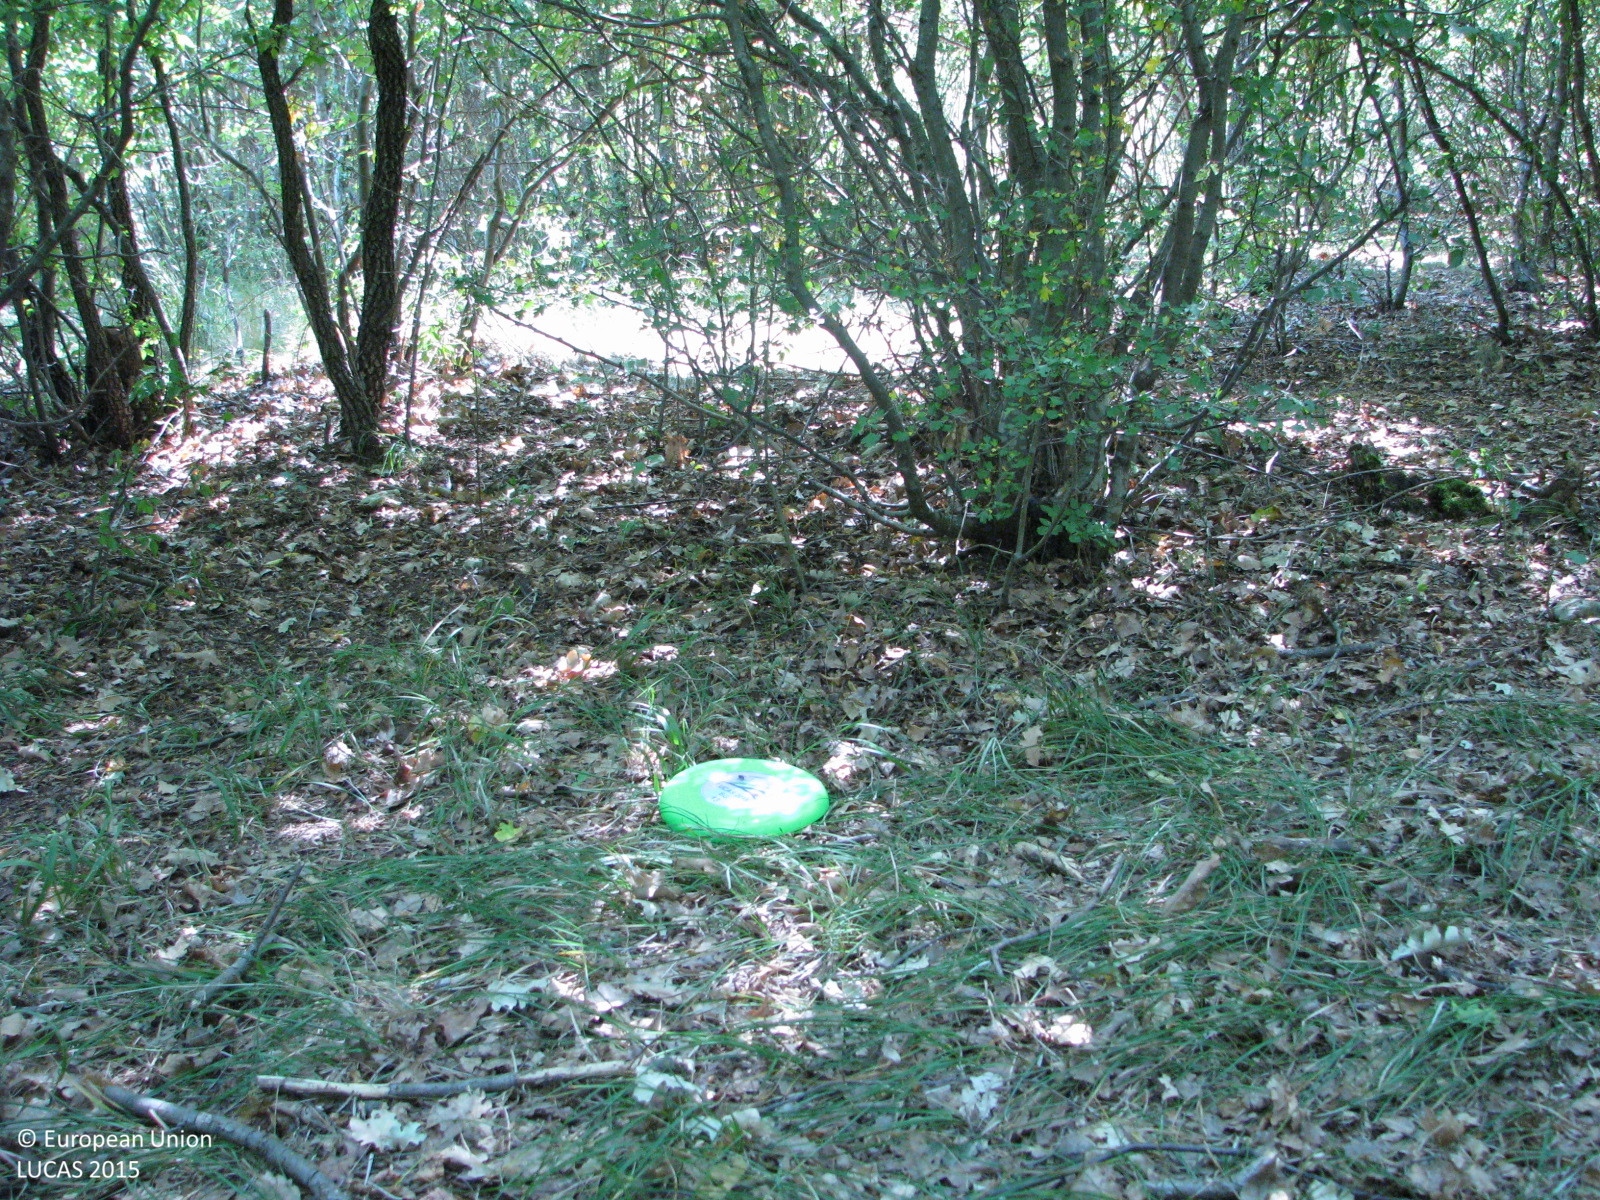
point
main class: Woodland
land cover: Broadleaved woodland
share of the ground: 50 - 75 %
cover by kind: broadleaved forest trees 50 %, herbaceous plants 40 %, shrubs 10 %
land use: Forestry
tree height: < 5 m
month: July
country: BG
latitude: 42.6466
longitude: 26.0746
